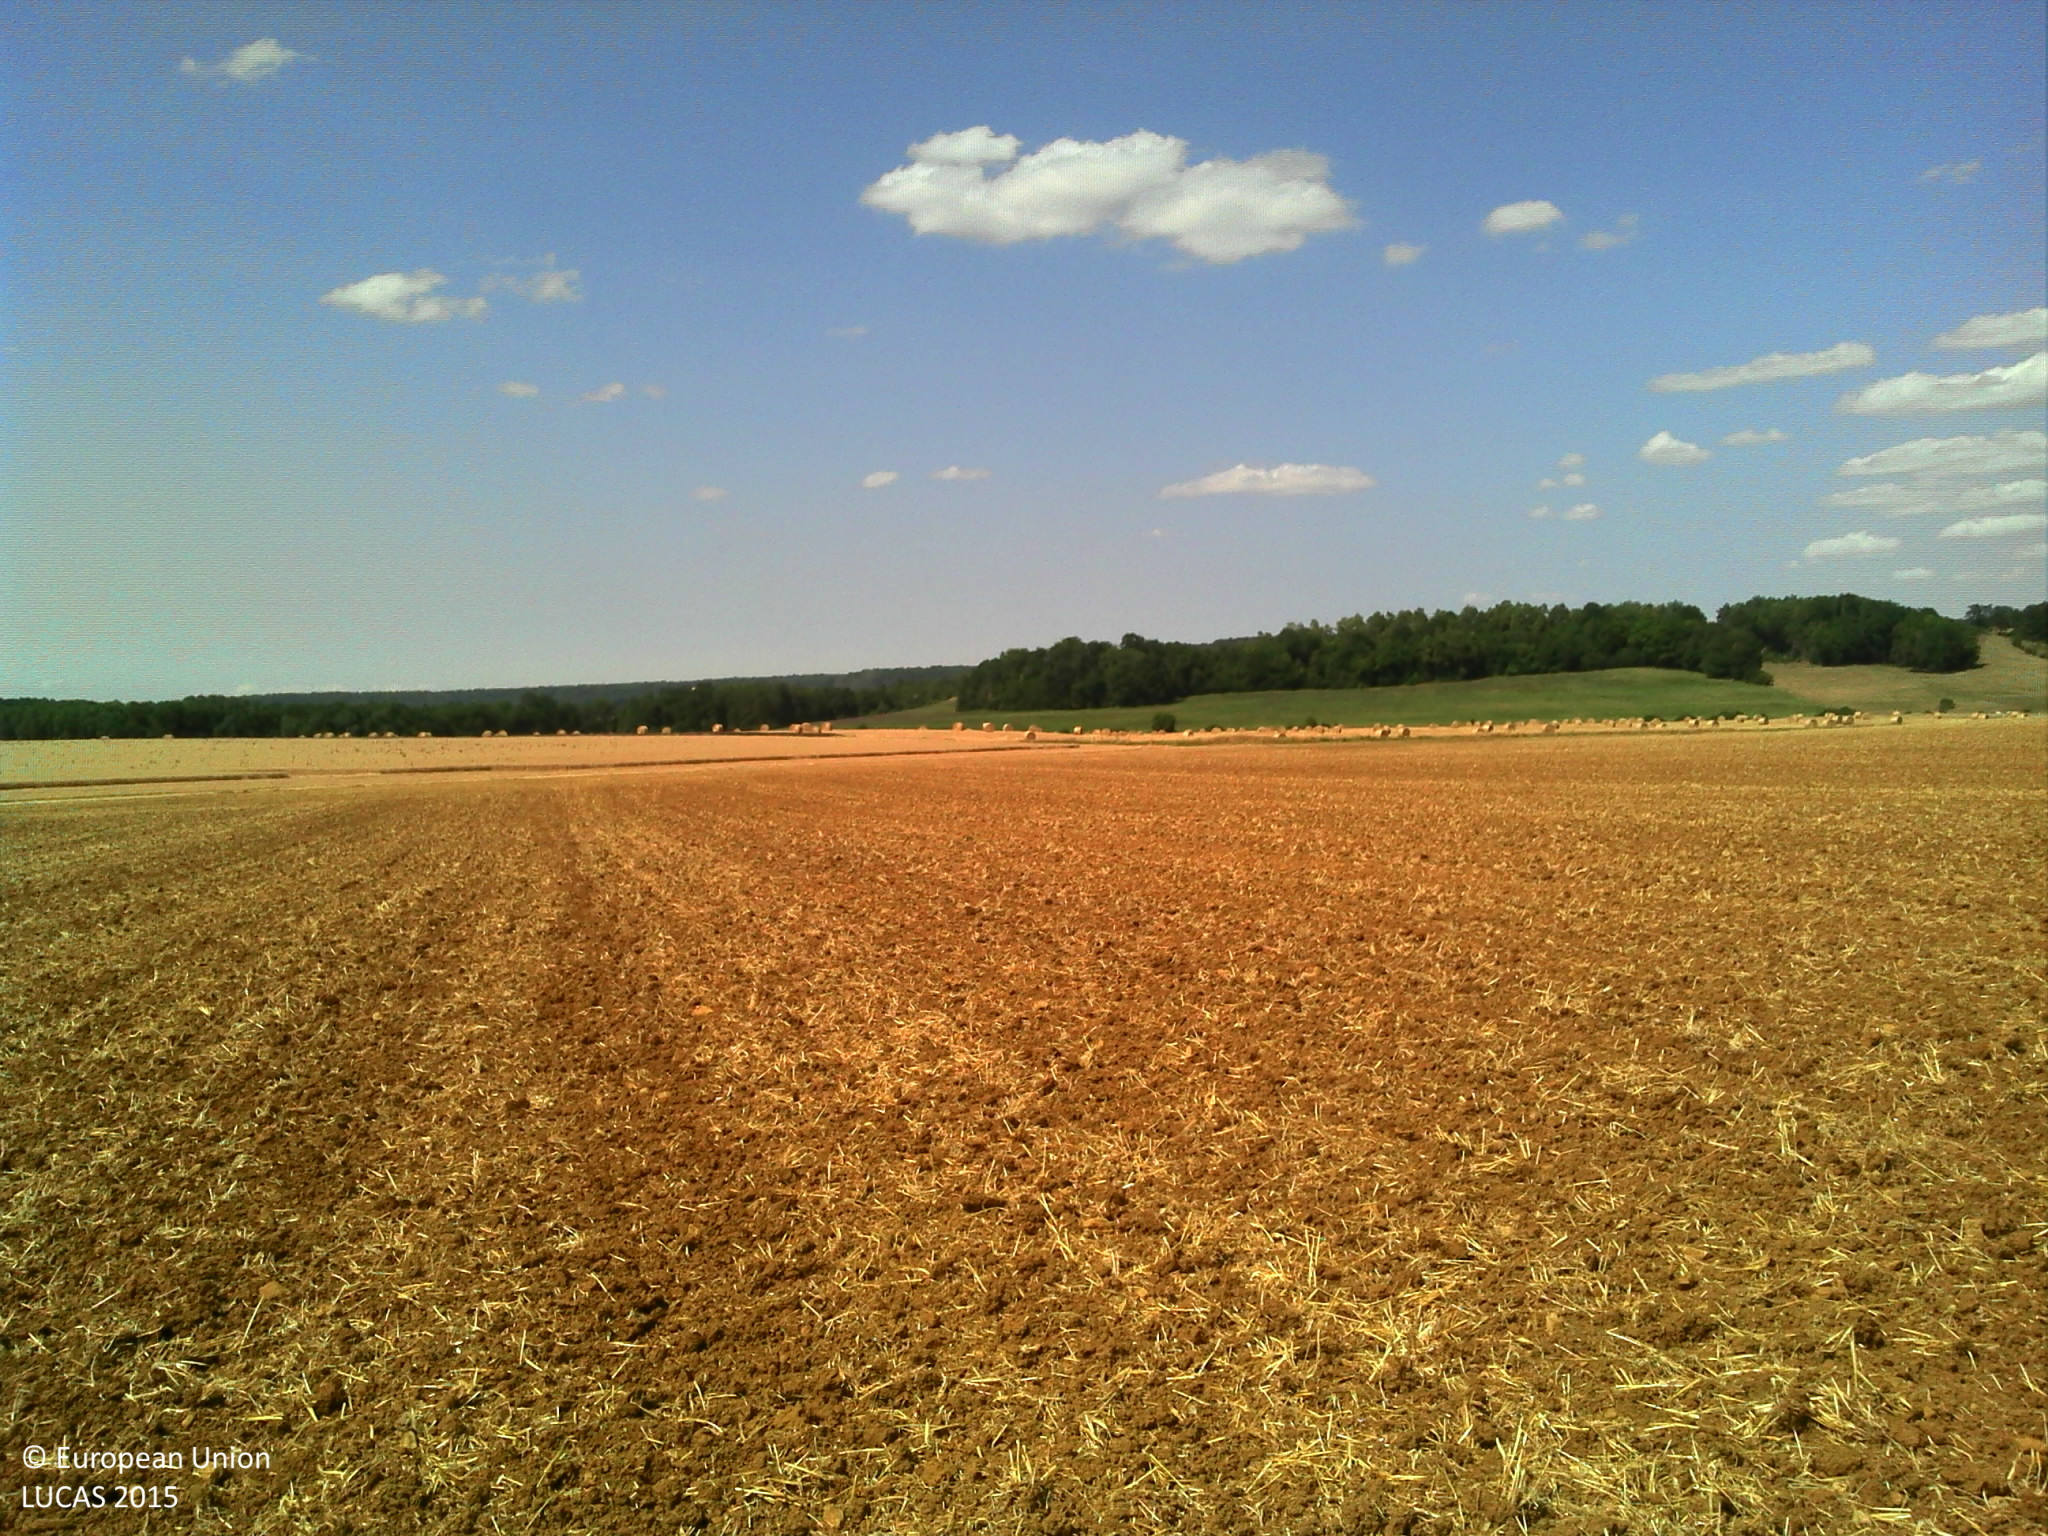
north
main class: Cropland
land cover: Barley
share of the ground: < 10 %
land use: Agriculture (excluding fallow land and kitchen gardens)
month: July
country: FR
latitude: 48.0917
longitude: 4.9910
